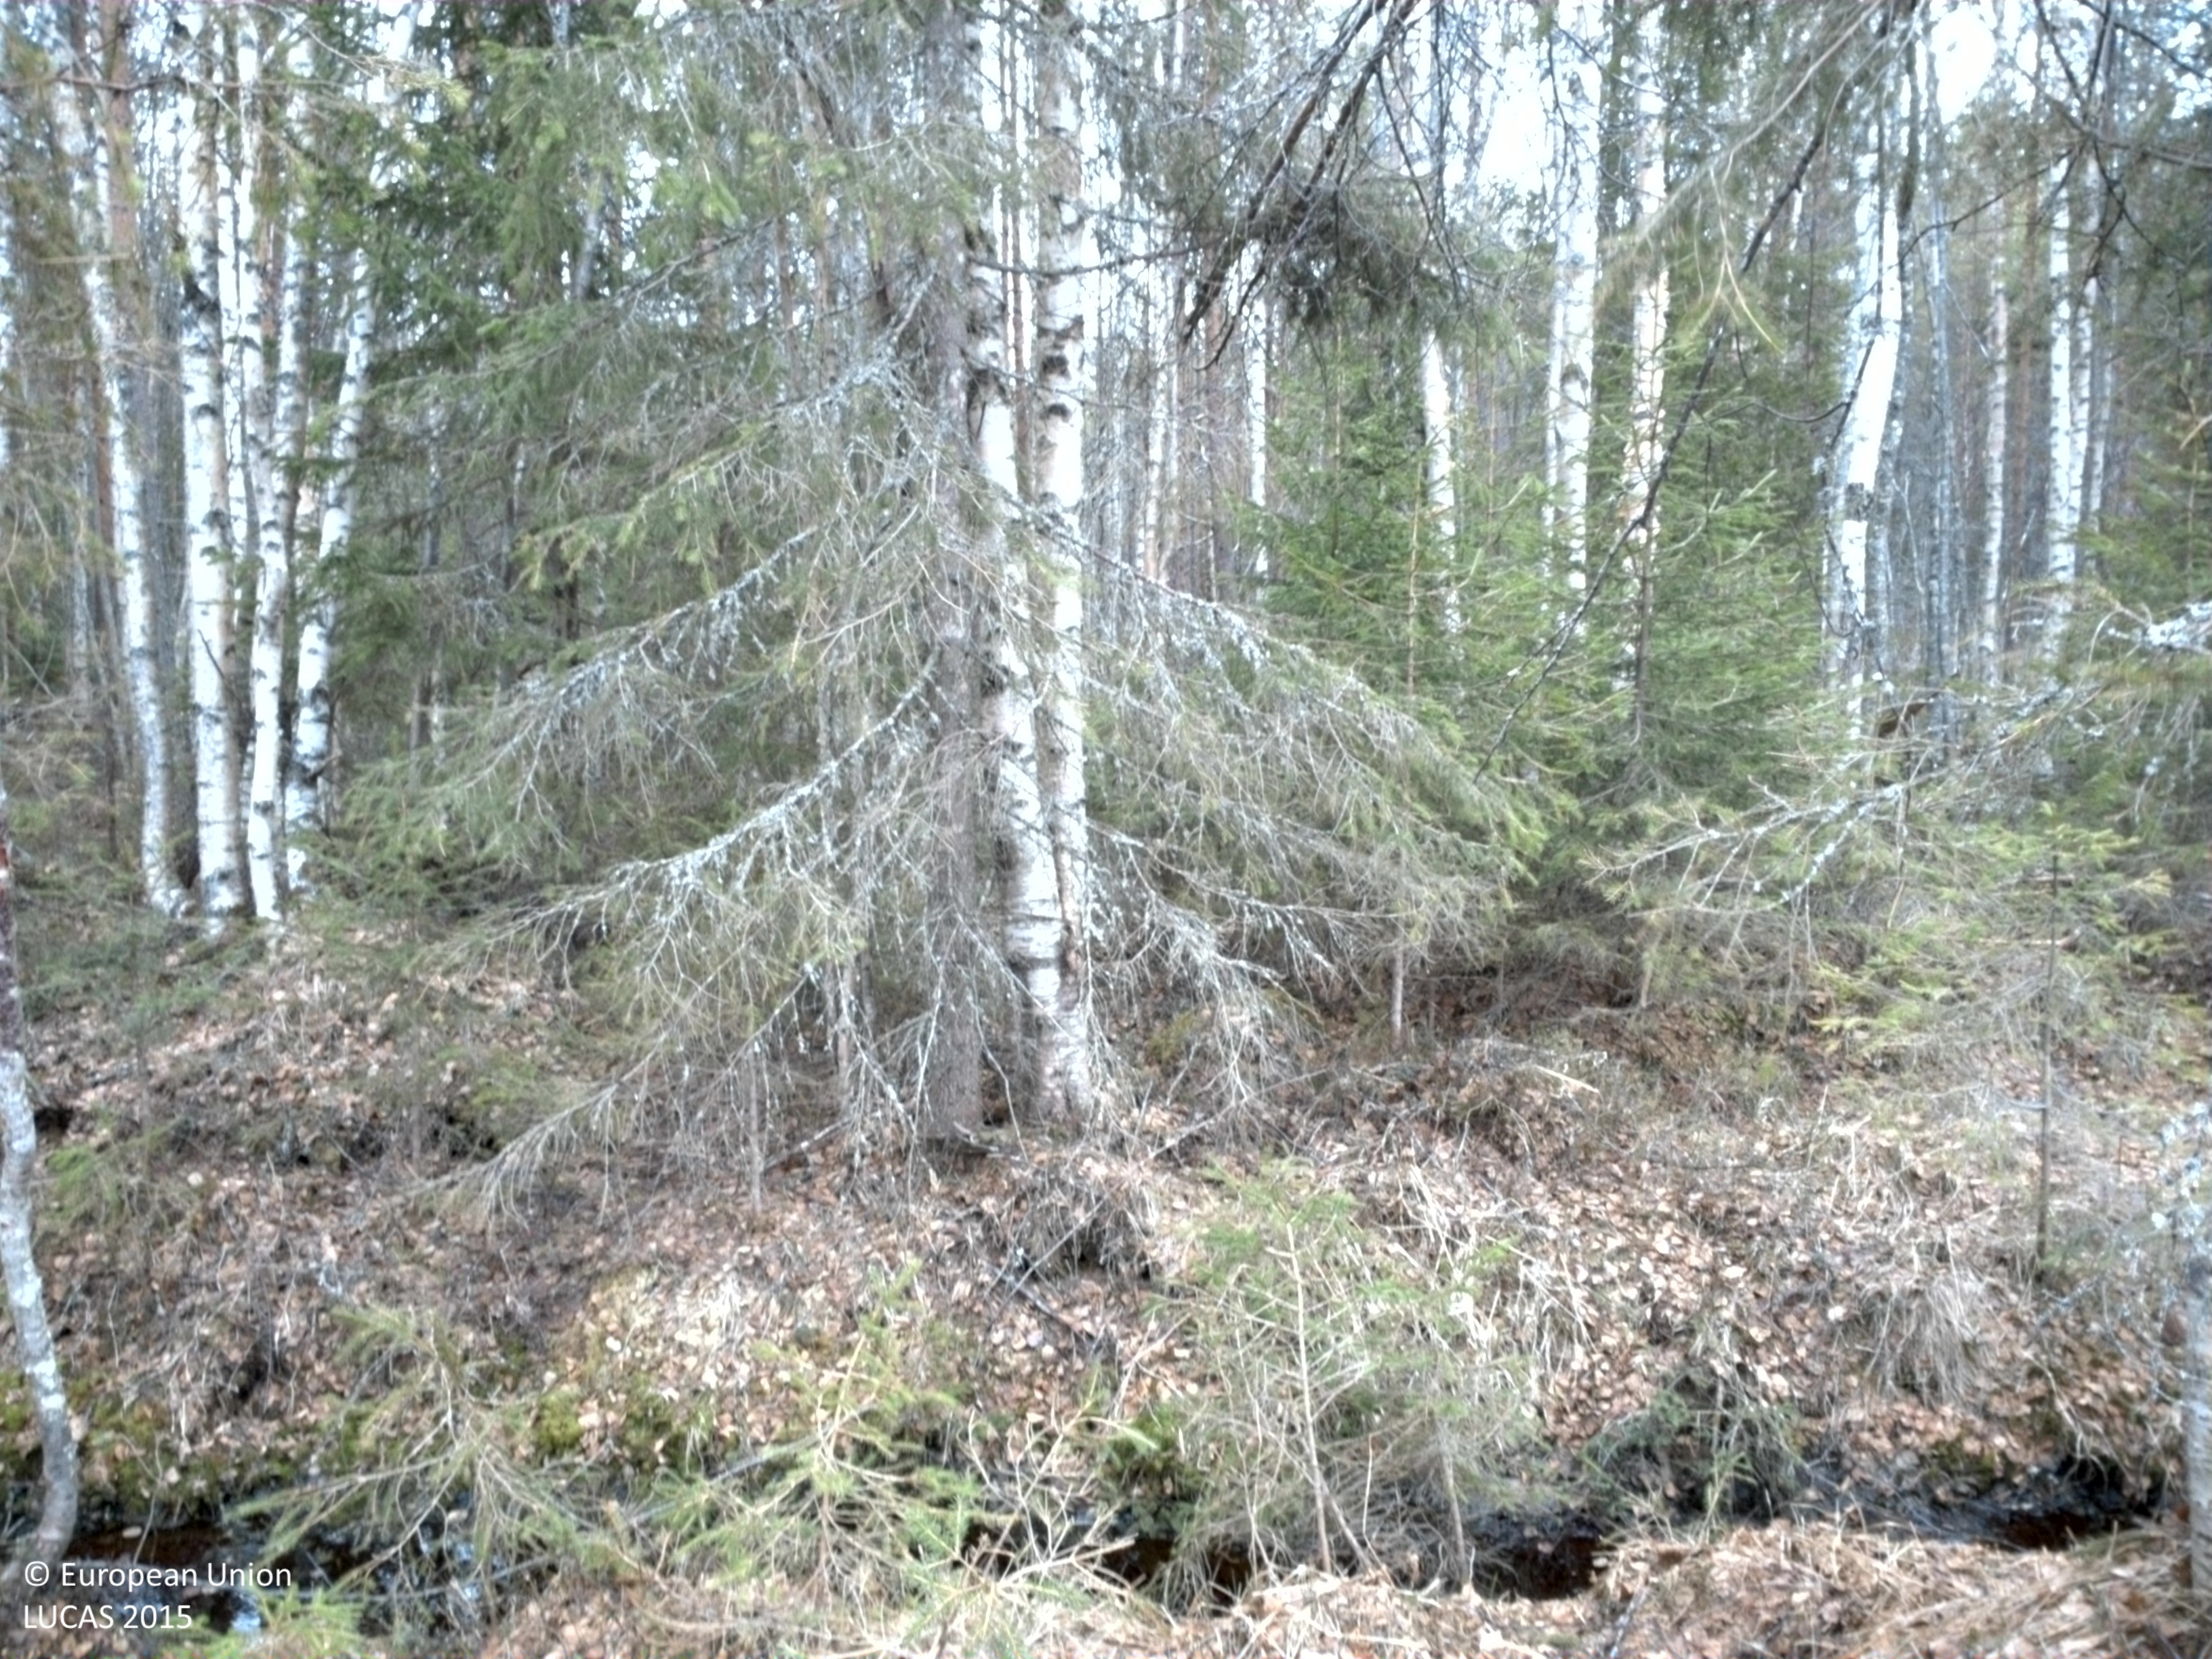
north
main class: Woodland
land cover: Pine dominated mixed woodland
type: boreal forest
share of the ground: > 75 %
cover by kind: coniferous forest trees 60 %, broadleaved forest trees 20 %, herbaceous plants 15 %, shrubs 5 %
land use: Forestry
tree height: > 5 m
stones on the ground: < 10 %
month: May
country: SE
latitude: 65.7661
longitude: 23.0664
